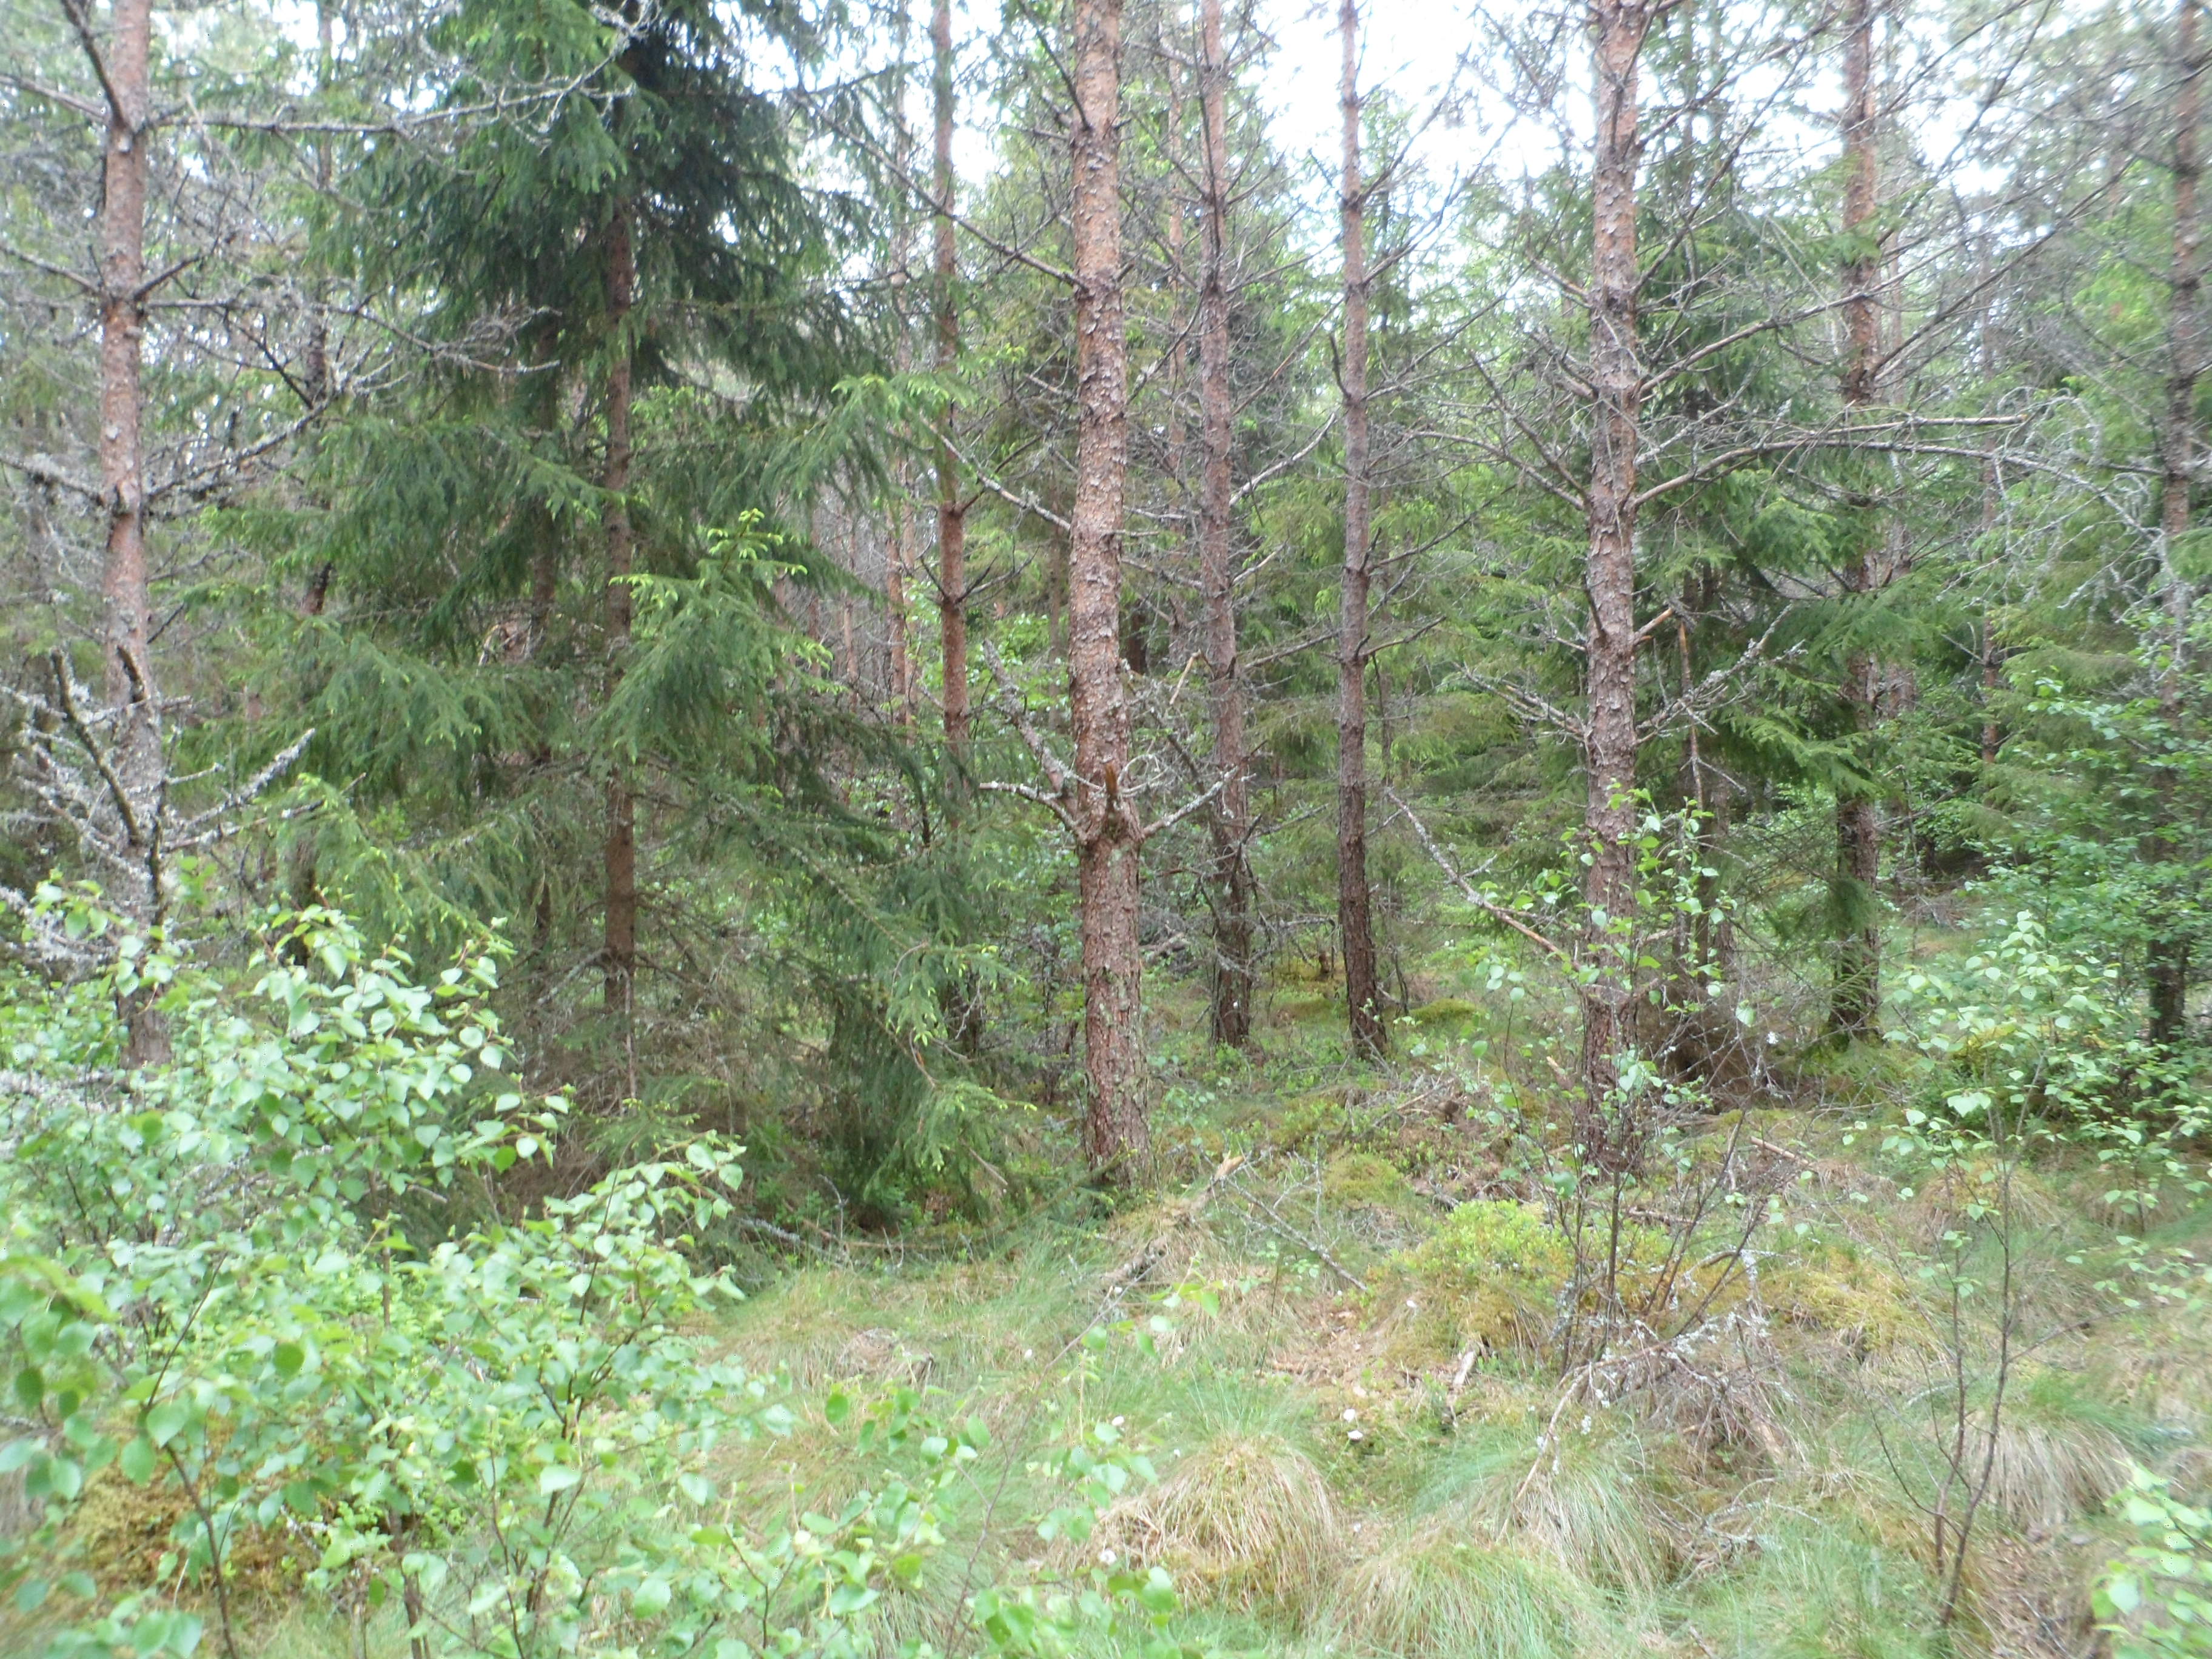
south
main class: Woodland
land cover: Pine dominated coniferous woodland
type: boreal forest
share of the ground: 50 - 75 %
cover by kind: coniferous forest trees 55 %, herbaceous plants 20 %, broadleaved forest trees 10 %, shrubs 10 %, lichens and mosses 5 %
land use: Forestry
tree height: > 5 m
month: June
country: SE
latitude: 56.9738
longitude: 14.4878
